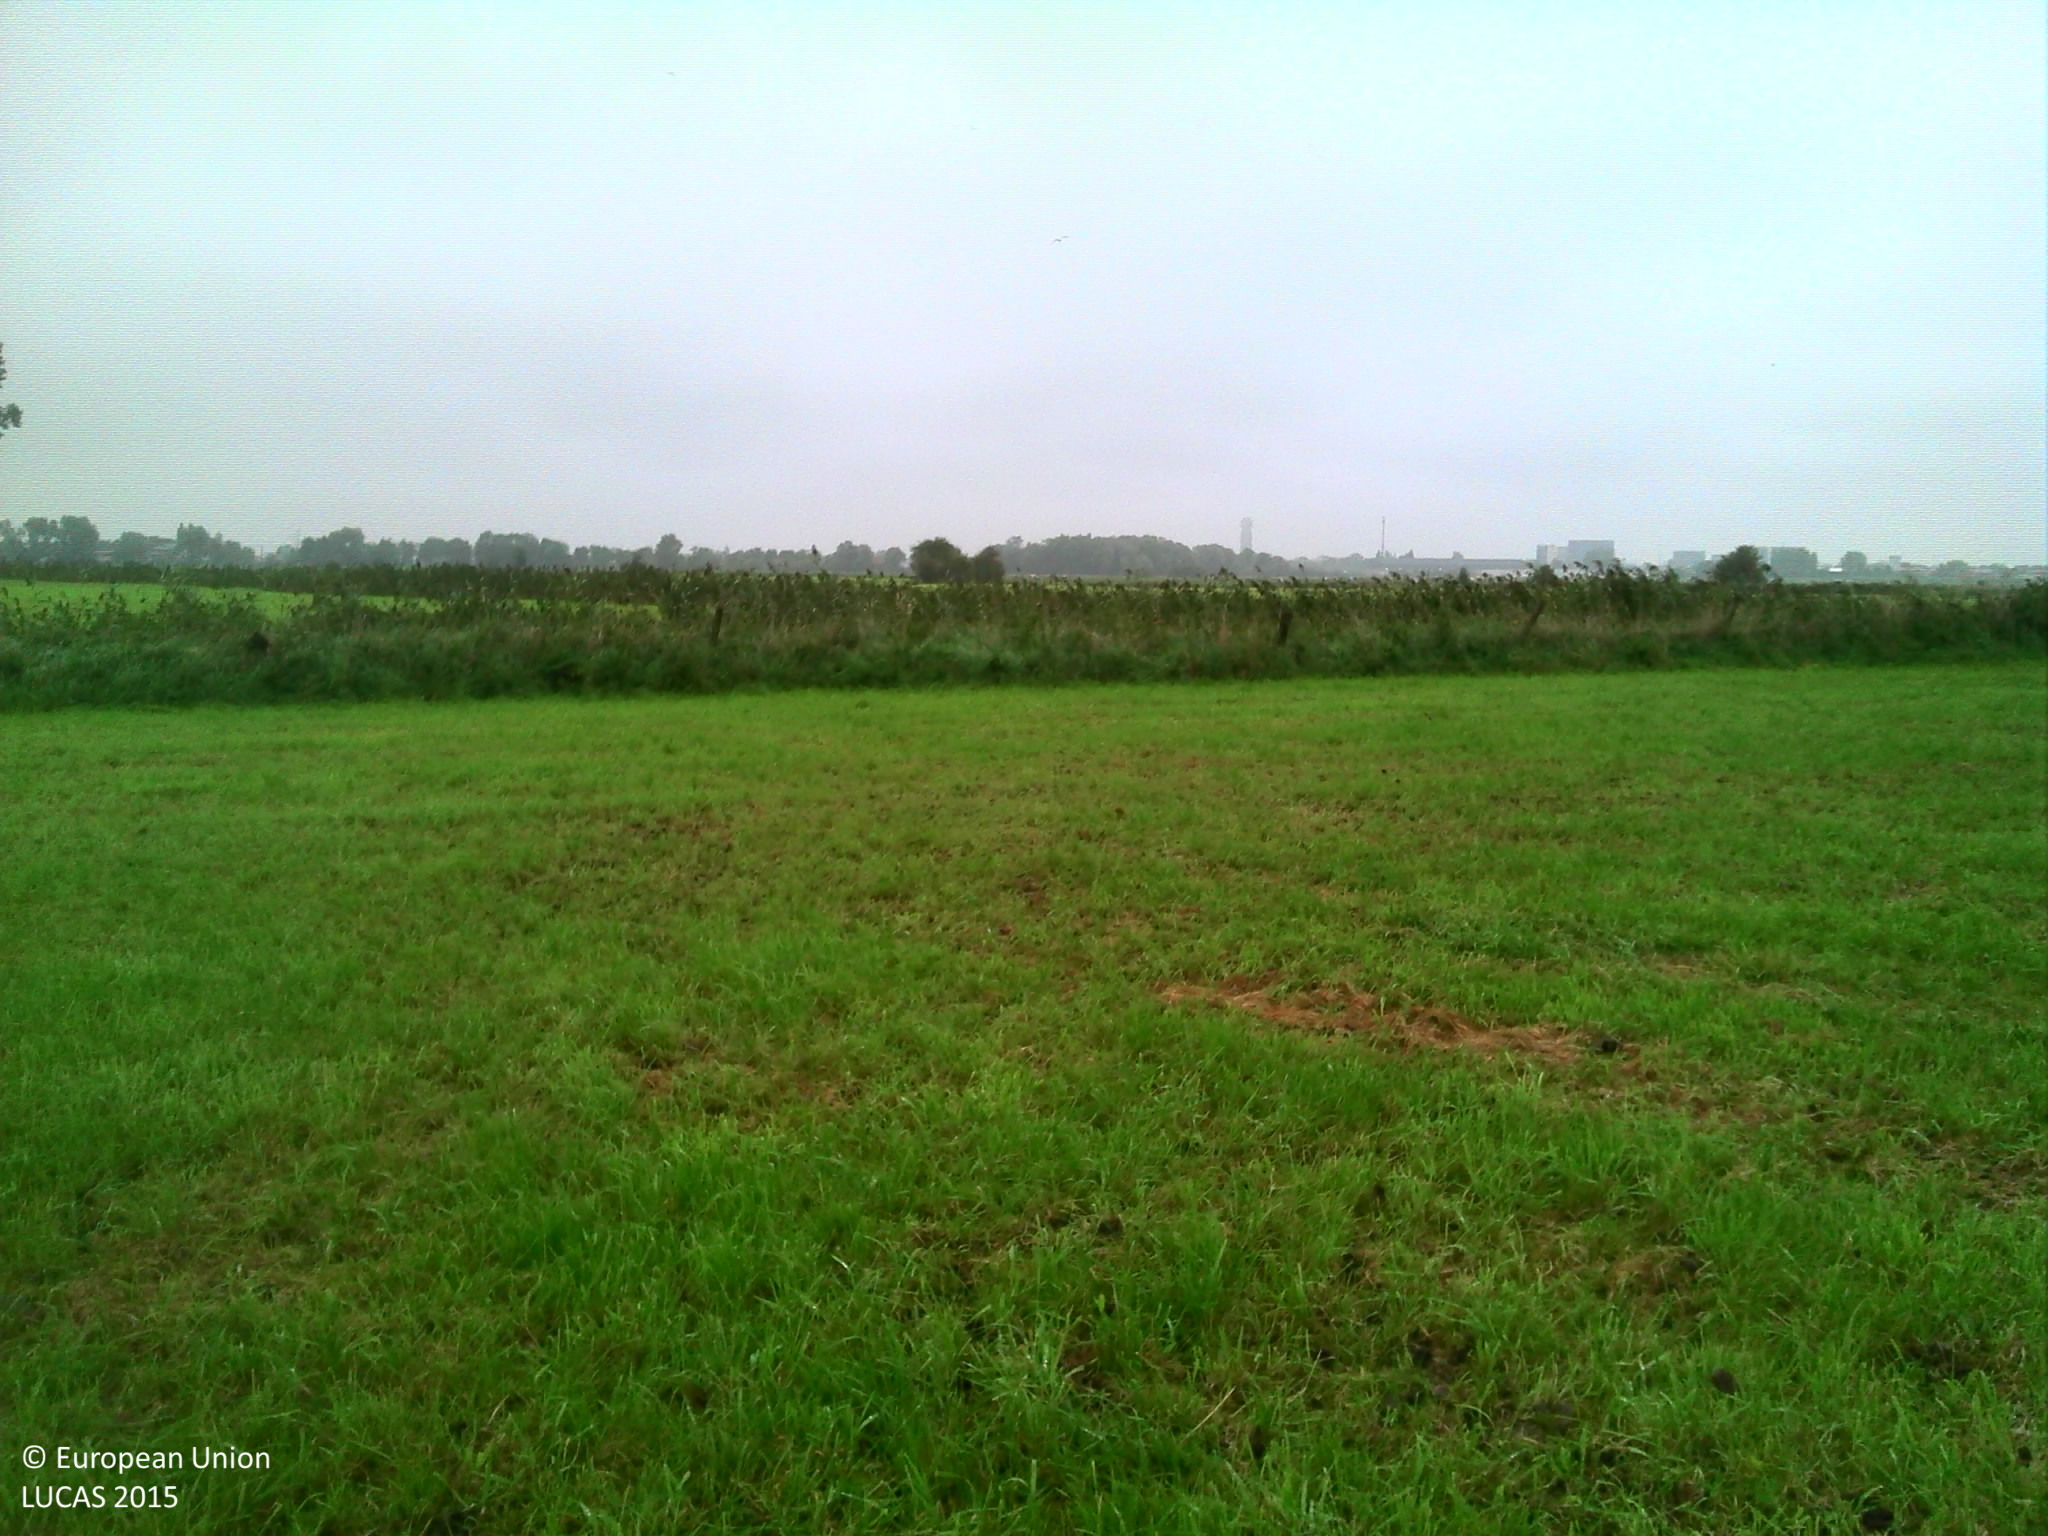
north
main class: Grassland
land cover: Grassland without tree/shrub cover
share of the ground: > 75 %
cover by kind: herbaceous plants 100 %
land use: Agriculture (excluding fallow land and kitchen gardens)
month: October
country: BE
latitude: 51.0066
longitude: 2.8490
